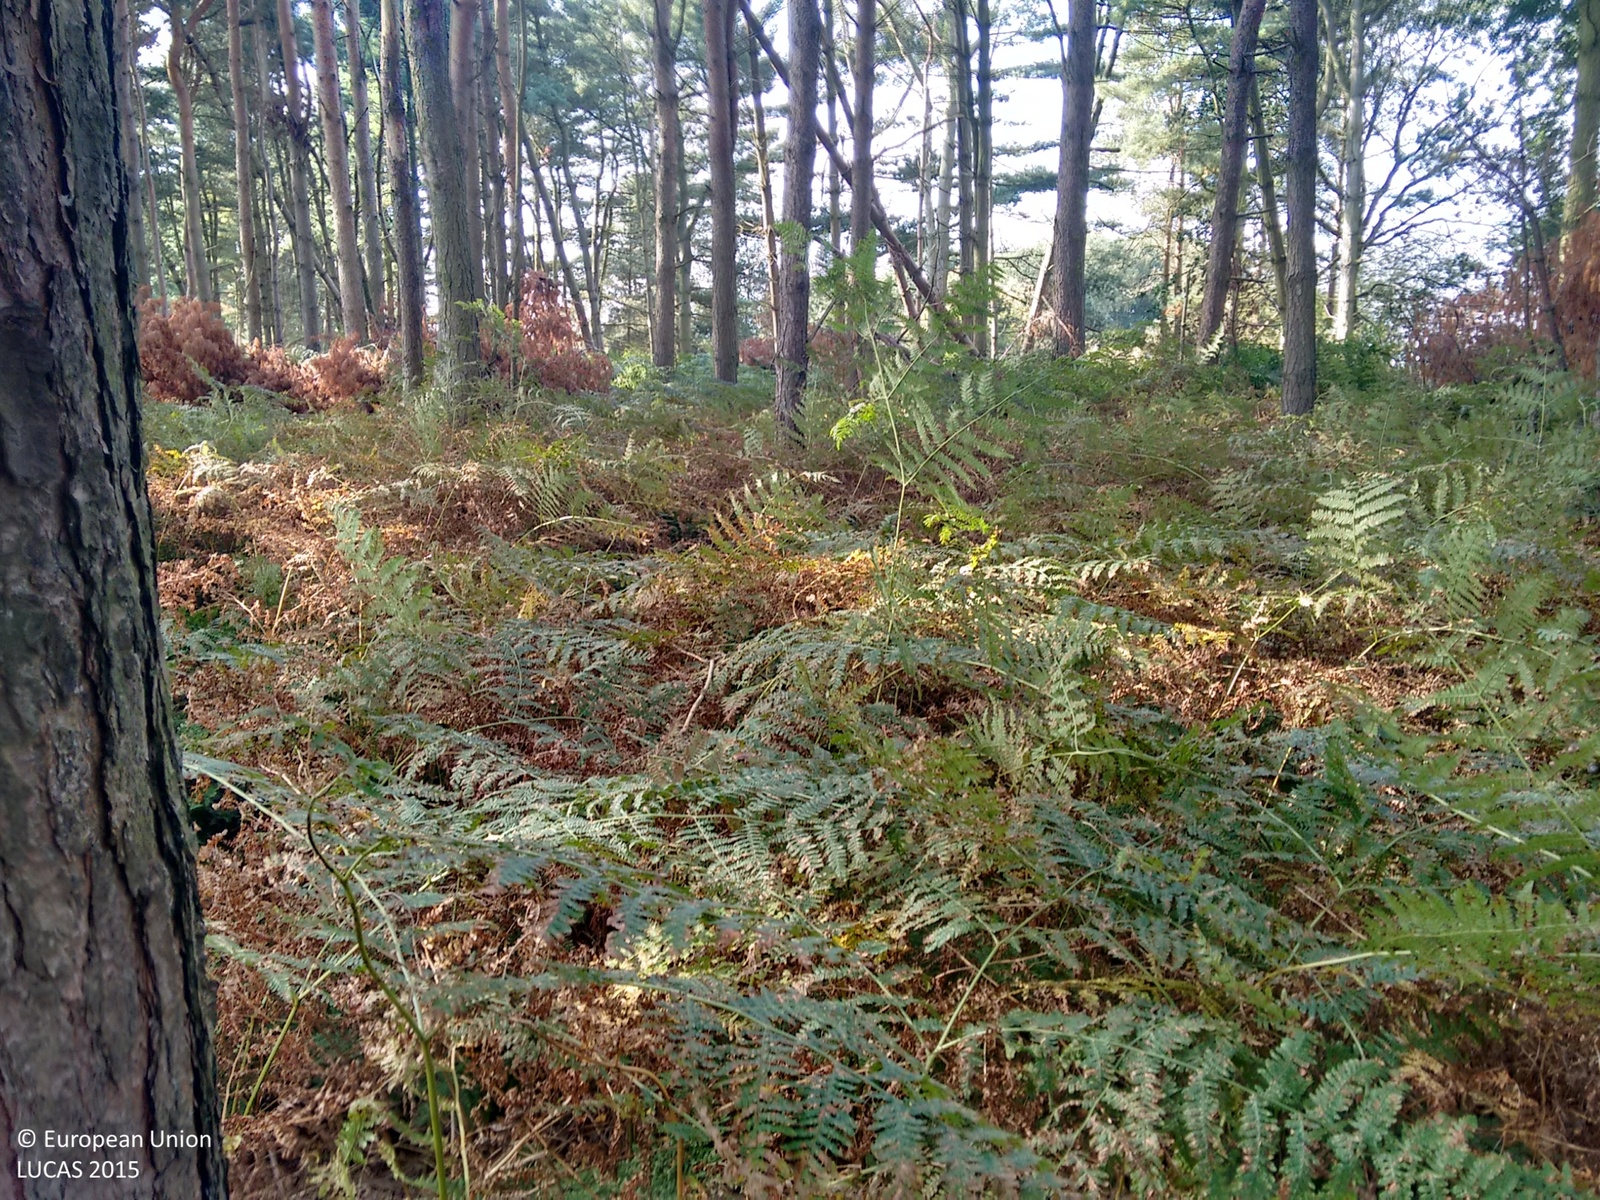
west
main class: Woodland
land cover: Pine dominated mixed woodland
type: exotic forest
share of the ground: > 75 %
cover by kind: coniferous forest trees 75 %, broadleaved forest trees 25 %
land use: Forestry
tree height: > 5 m
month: September
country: GB
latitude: 52.4568
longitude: 0.8367
